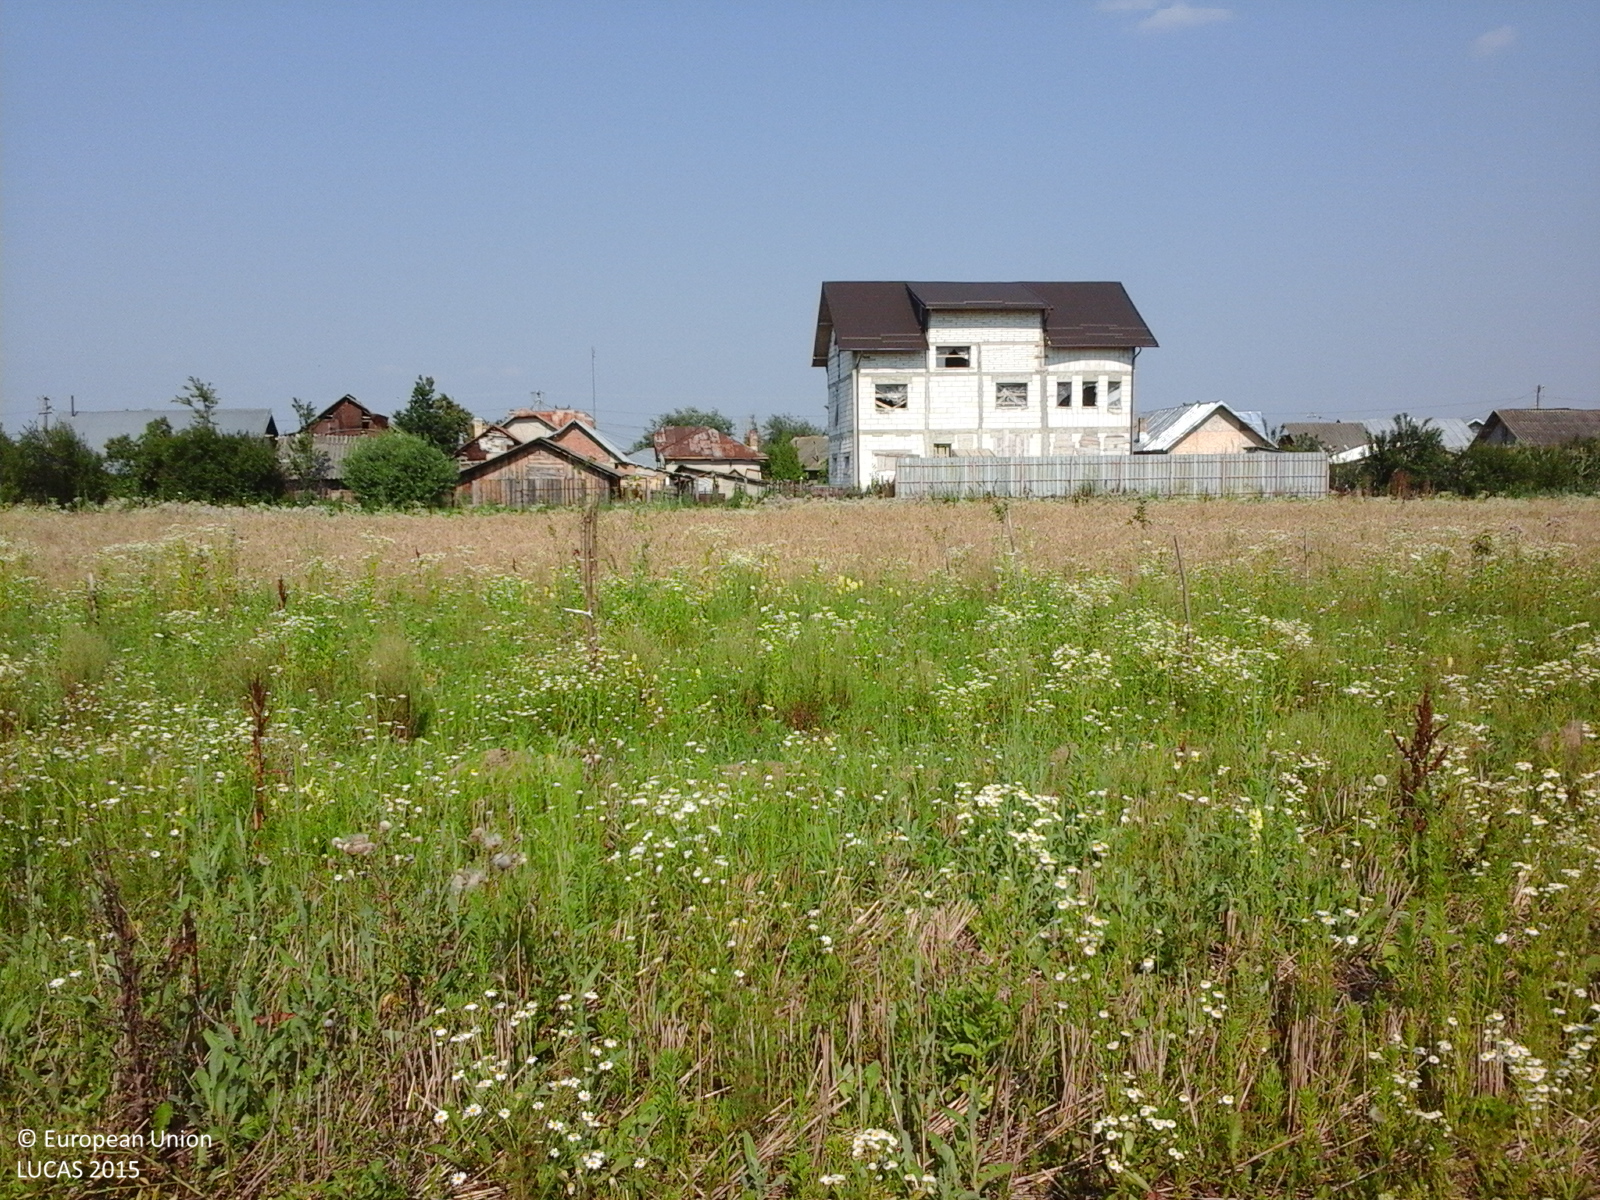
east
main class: Grassland
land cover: Spontaneously vegetated surfaces
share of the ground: > 75 %
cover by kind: herbaceous plants 100 %
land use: Fallow land
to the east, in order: Spontaneously vegetated surfaces; Common wheat; Grassland without tree/shrub cover; Artificial constructions in urban areas; Maize; Grassland without tree/shrub cover; Arable land (only in case pi)
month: July
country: RO
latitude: 44.8674
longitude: 25.6020
